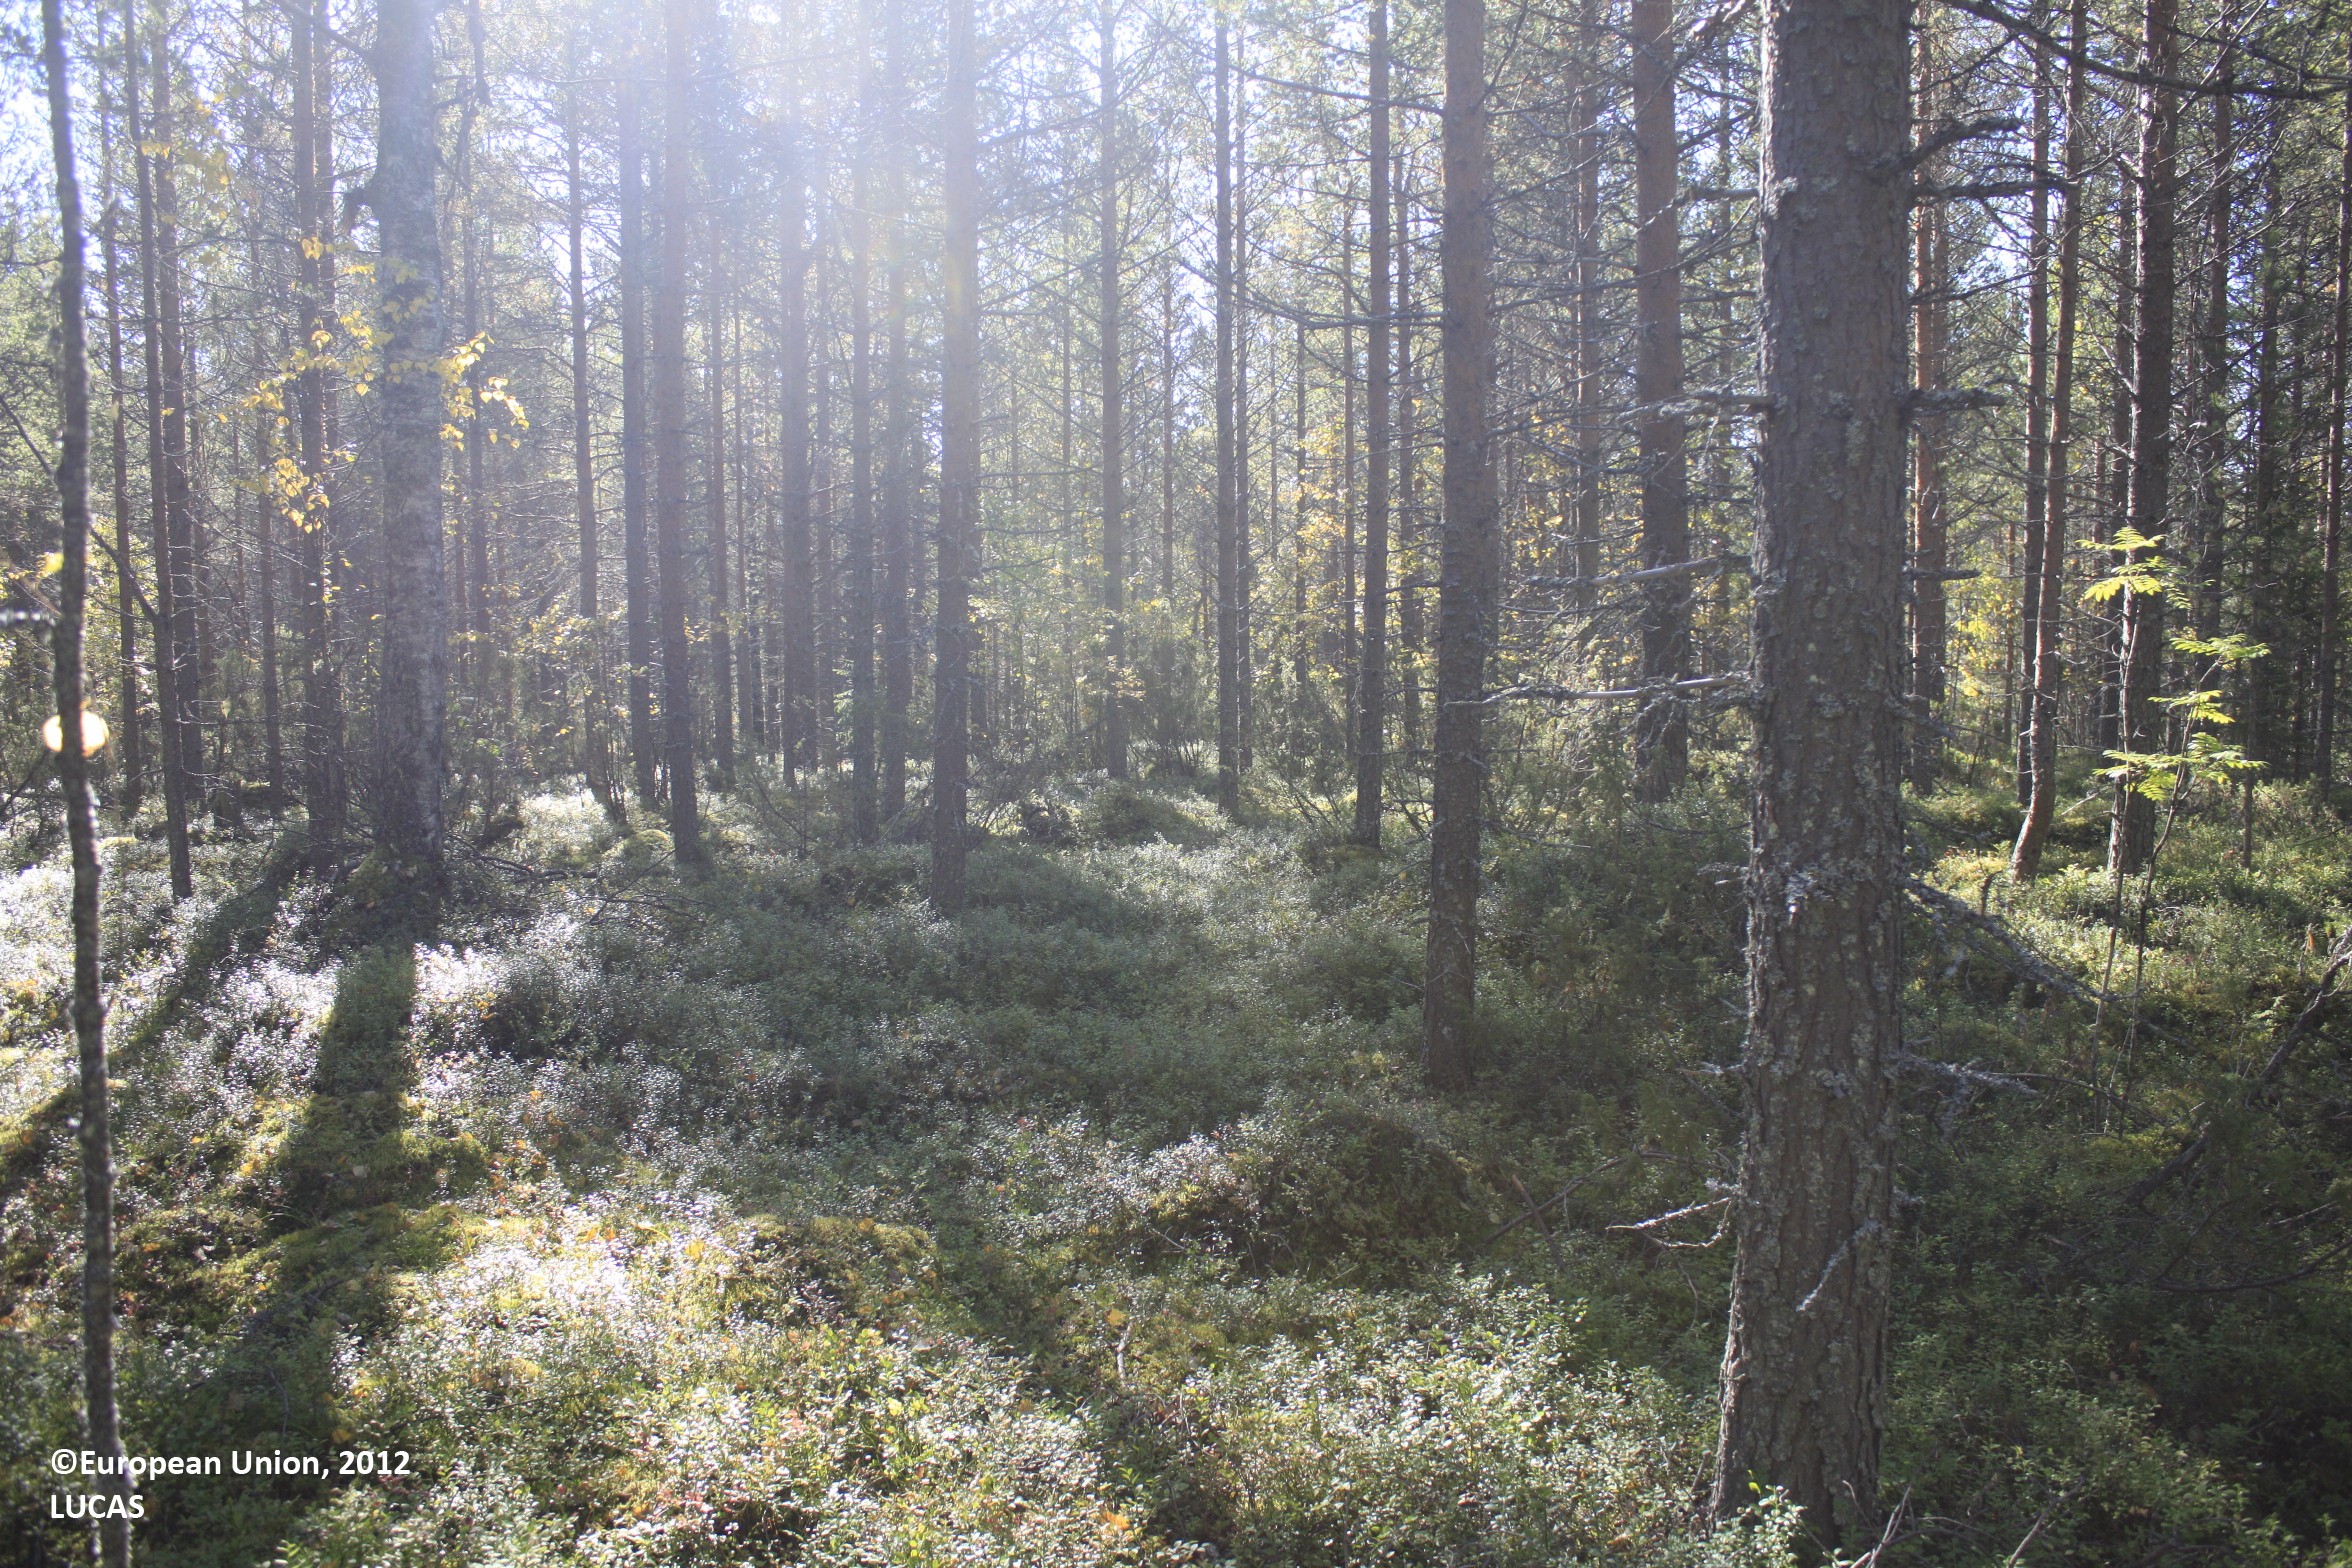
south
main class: Woodland
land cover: Pine dominated coniferous woodland
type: boreal forest
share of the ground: 25 - 50 %
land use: Forestry
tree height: > 5 m
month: September
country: FI
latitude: 65.8461
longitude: 26.8606
